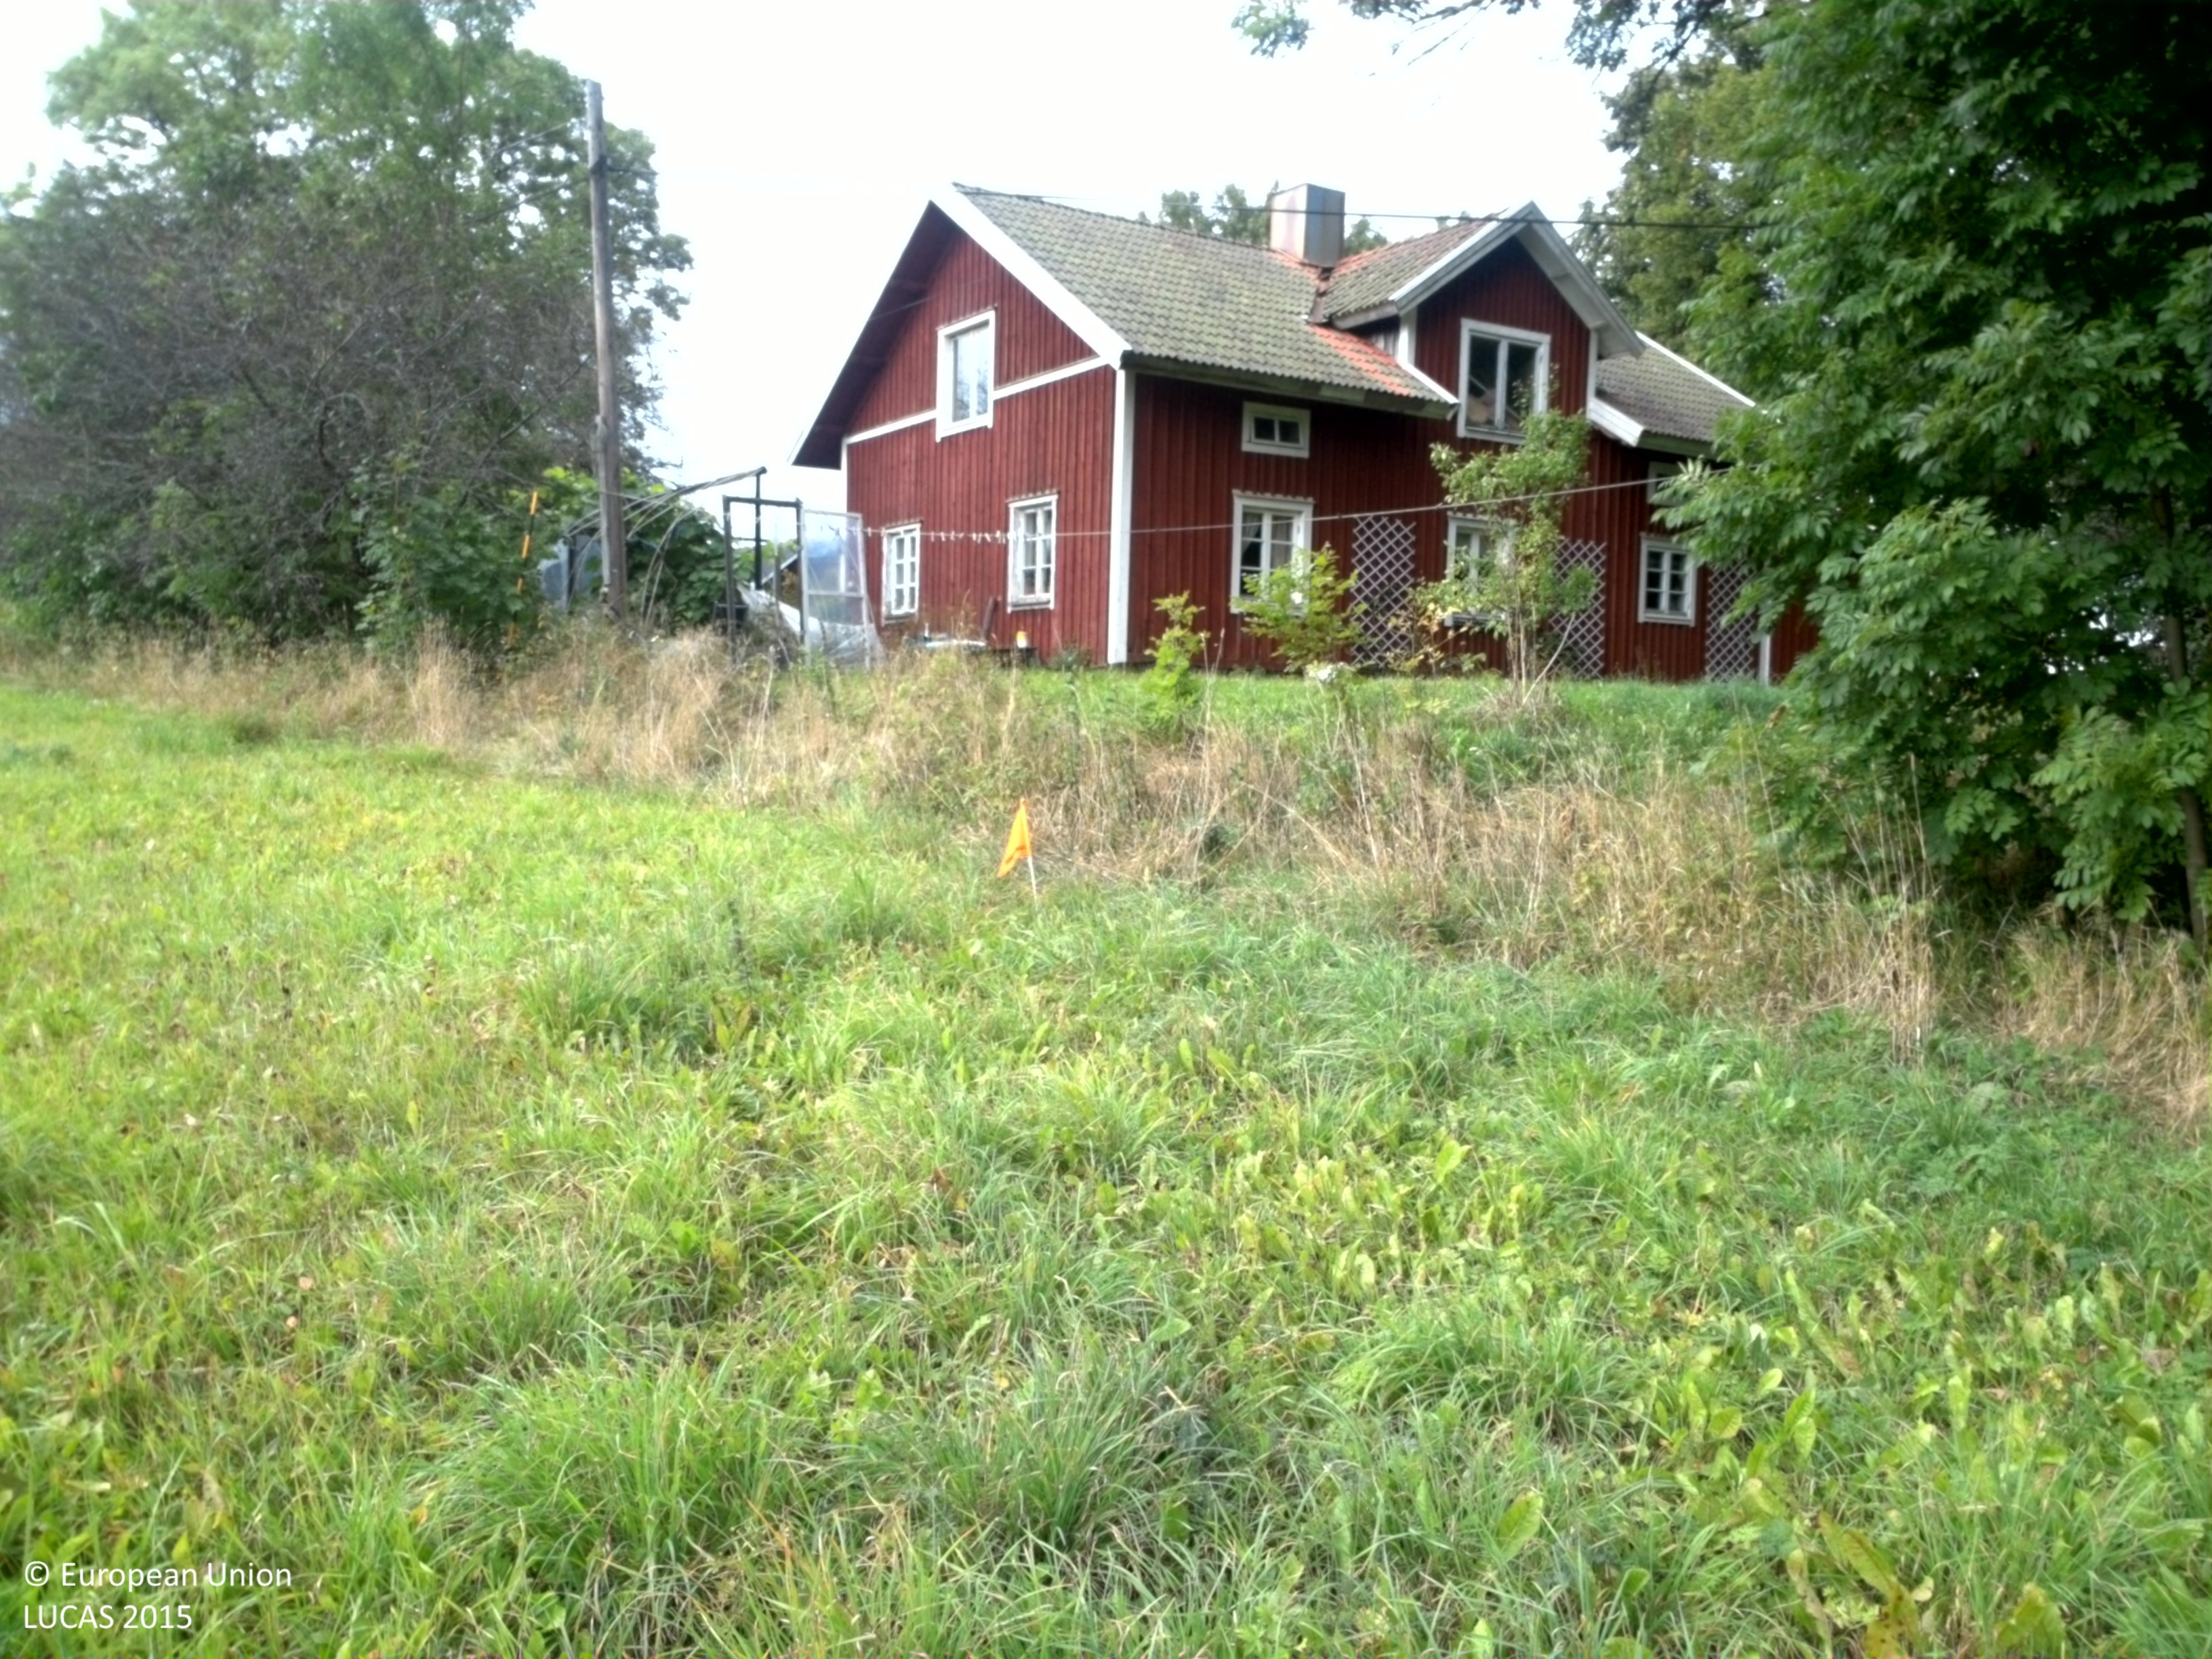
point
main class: Grassland
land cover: Grassland without tree/shrub cover
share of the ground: > 75 %
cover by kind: herbaceous plants 100 %
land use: Agriculture (excluding fallow land and kitchen gardens)
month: September
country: SE
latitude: 58.8700
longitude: 14.3455
